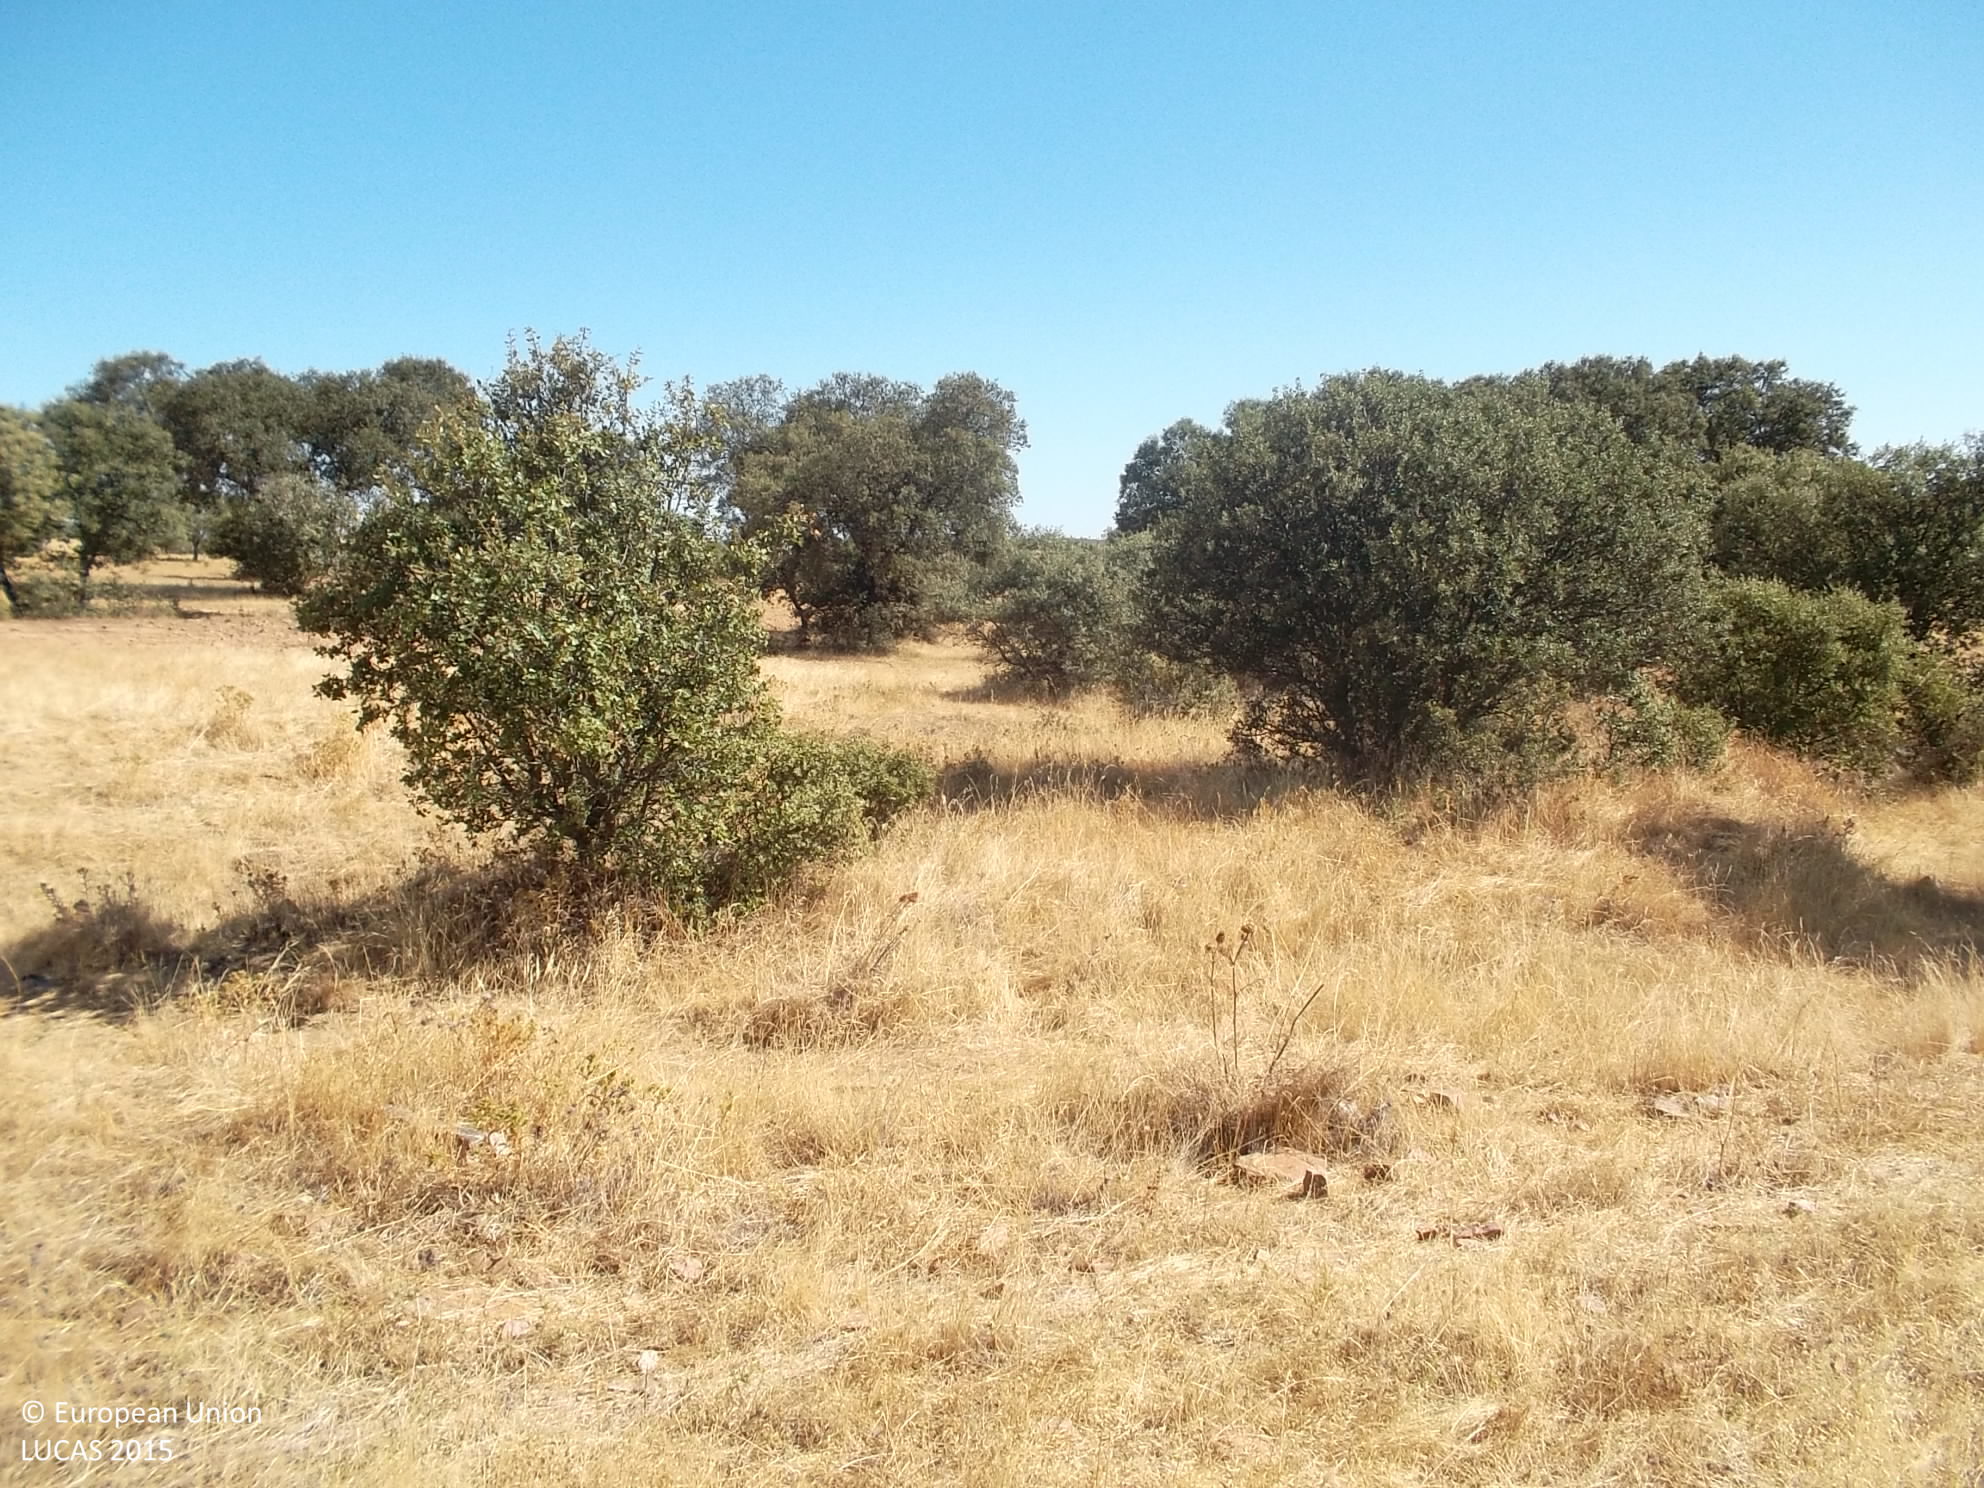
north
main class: Grassland
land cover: Grassland with sparse tree/shrub cover
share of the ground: > 75 %
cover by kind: herbaceous plants 90 %, broadleaved forest trees 5 %, shrubs 5 %
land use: Agriculture (excluding fallow land and kitchen gardens)
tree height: < 5 m
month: July
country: ES
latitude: 38.4555
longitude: -5.8428
